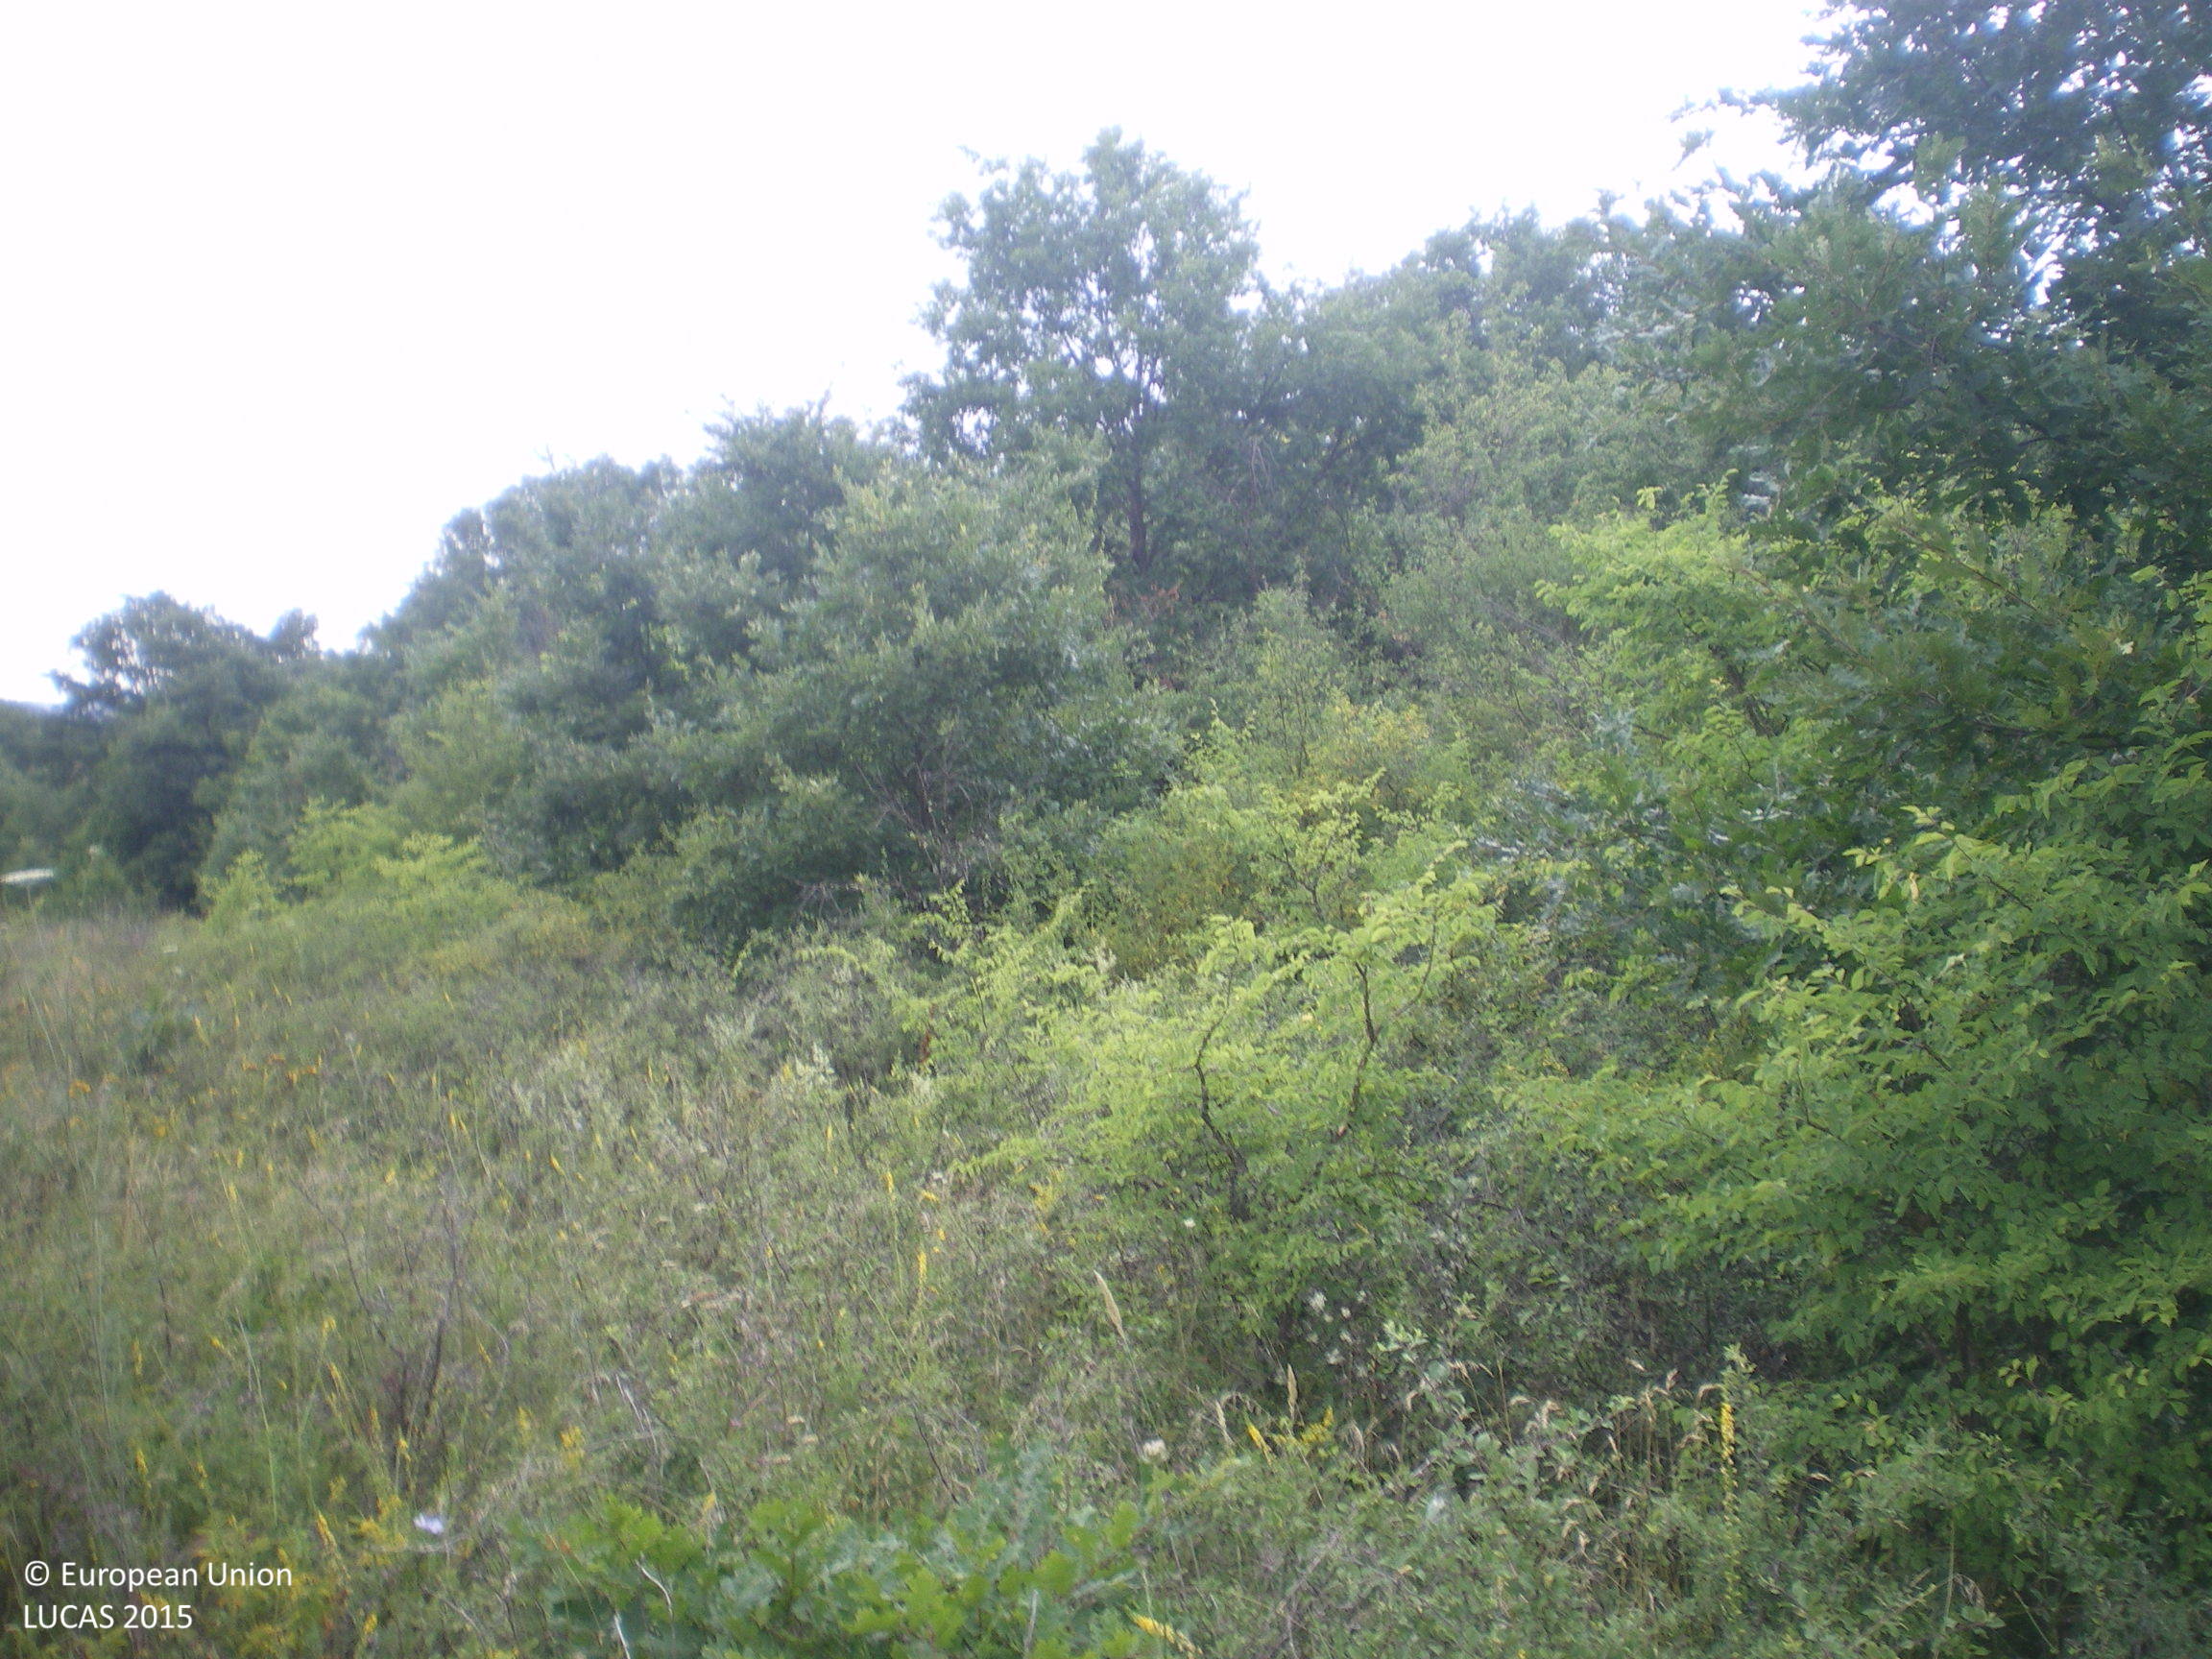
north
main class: Woodland
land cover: Broadleaved woodland
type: mesophytic deciduous forest
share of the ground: 50 - 75 %
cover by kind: broadleaved forest trees 50 %, herbaceous plants 30 %, shrubs 20 %
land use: Forestry
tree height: > 5 m
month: July
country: BG
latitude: 42.4173
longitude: 25.1929
